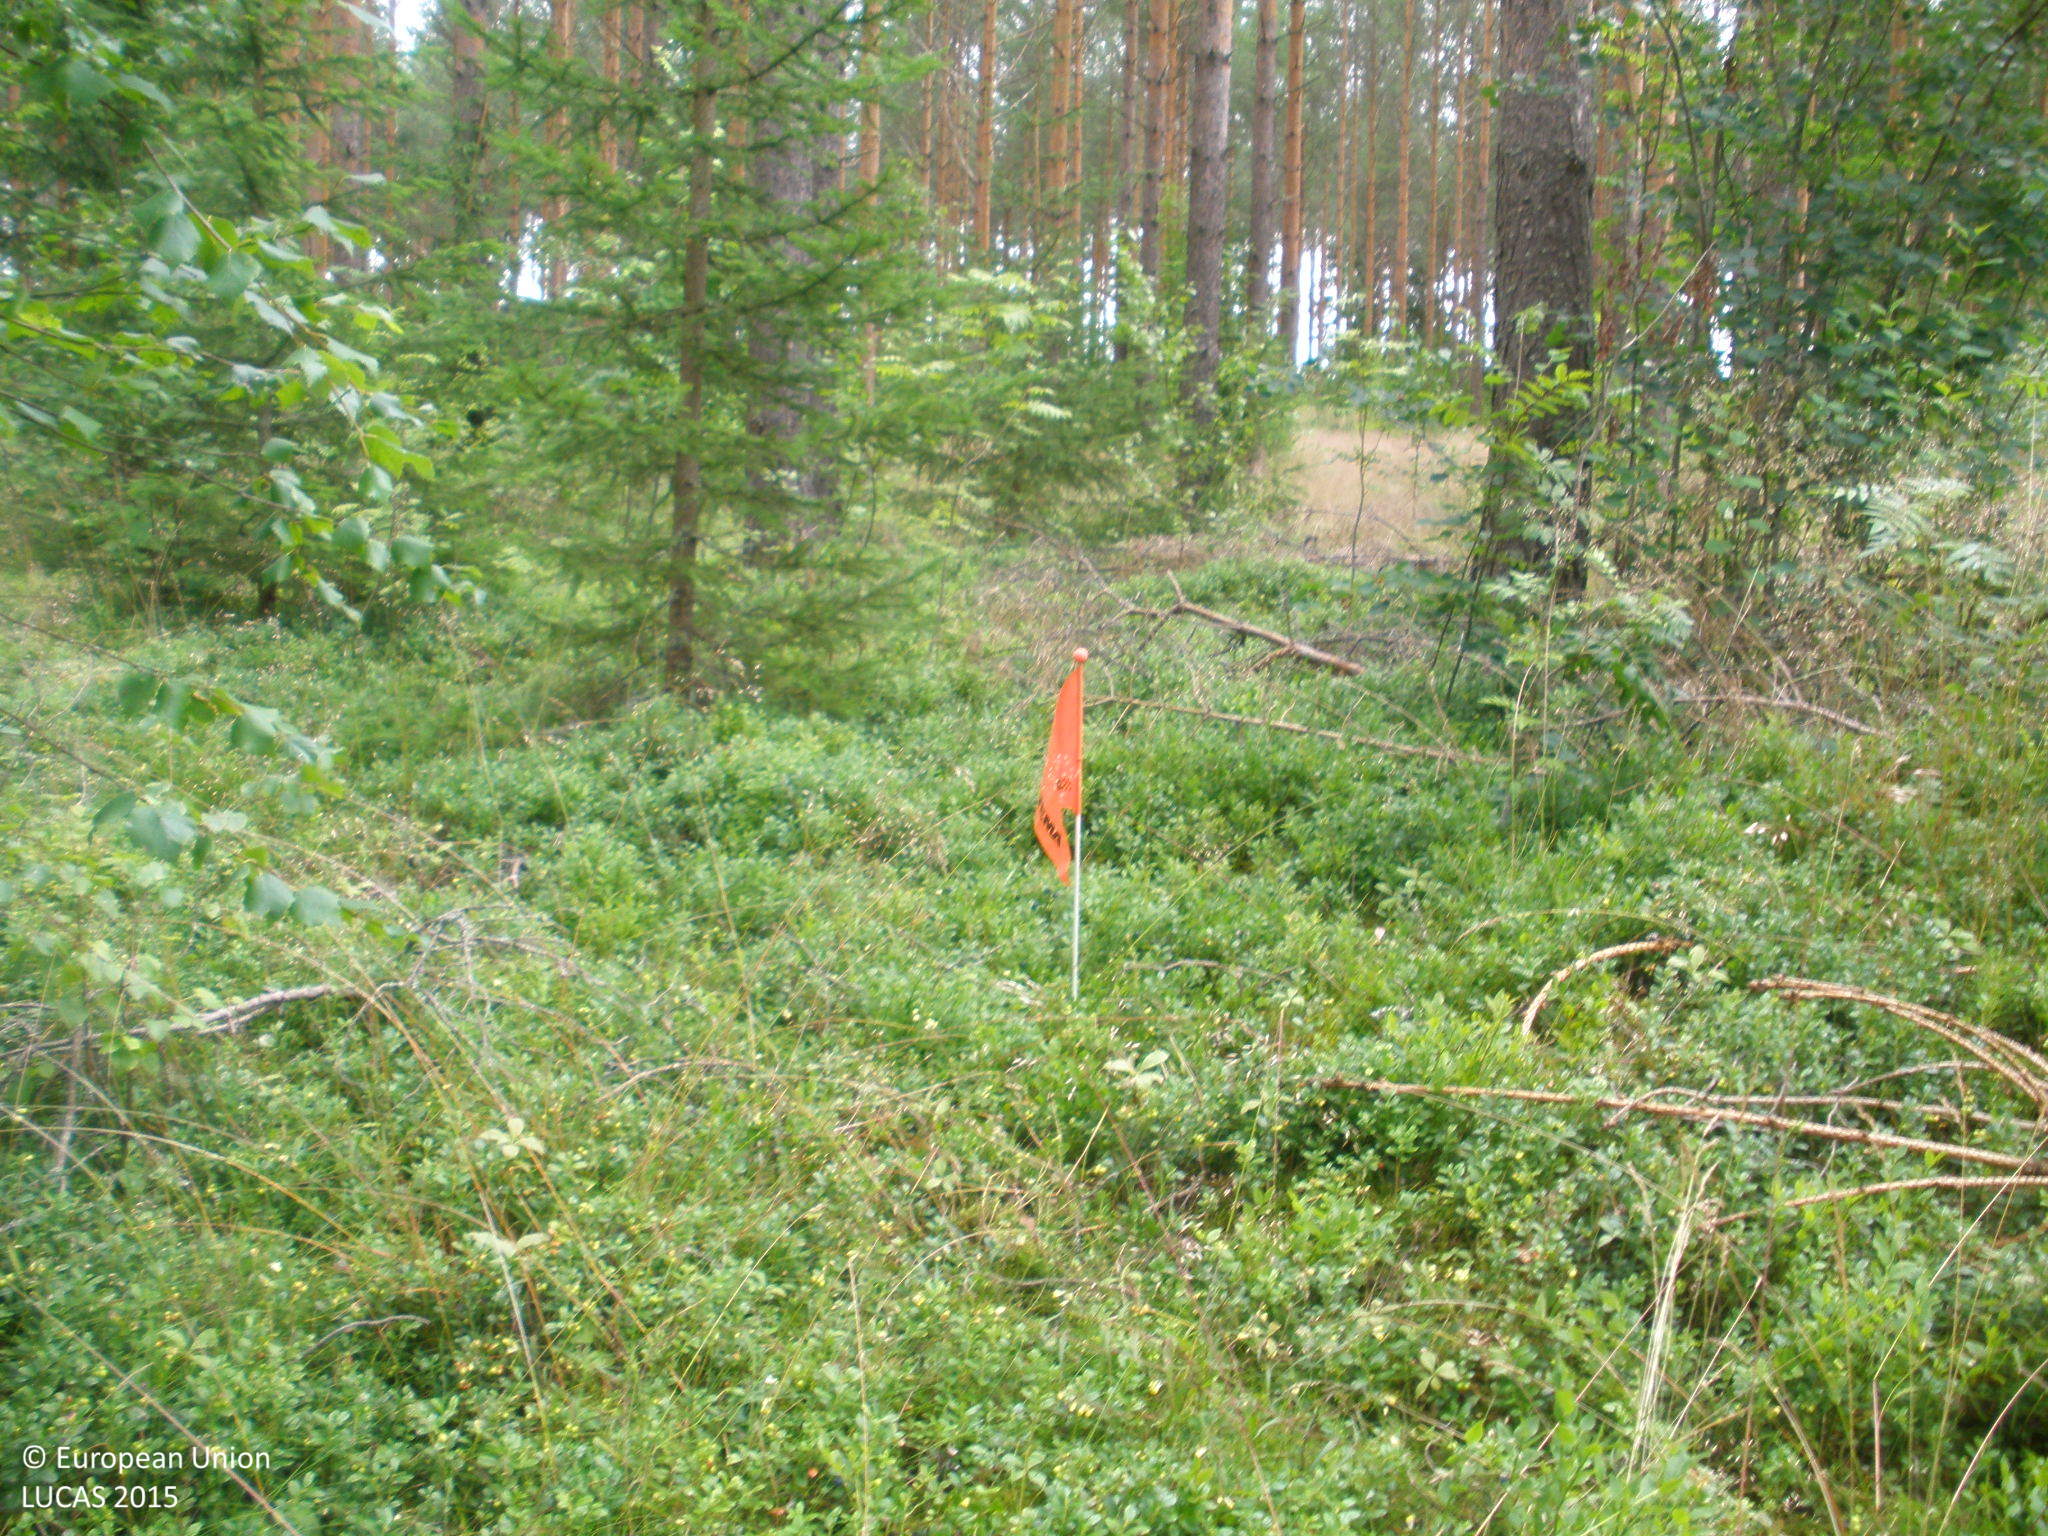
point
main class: Woodland
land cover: Pine dominated mixed woodland
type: boreal forest
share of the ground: 50 - 75 %
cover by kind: coniferous forest trees 50 %, broadleaved forest trees 20 %, herbaceous plants 15 %, shrubs 10 %, lichens and mosses 5 %
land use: Forestry
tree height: > 5 m
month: August
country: FI
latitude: 60.9048
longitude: 24.5770
